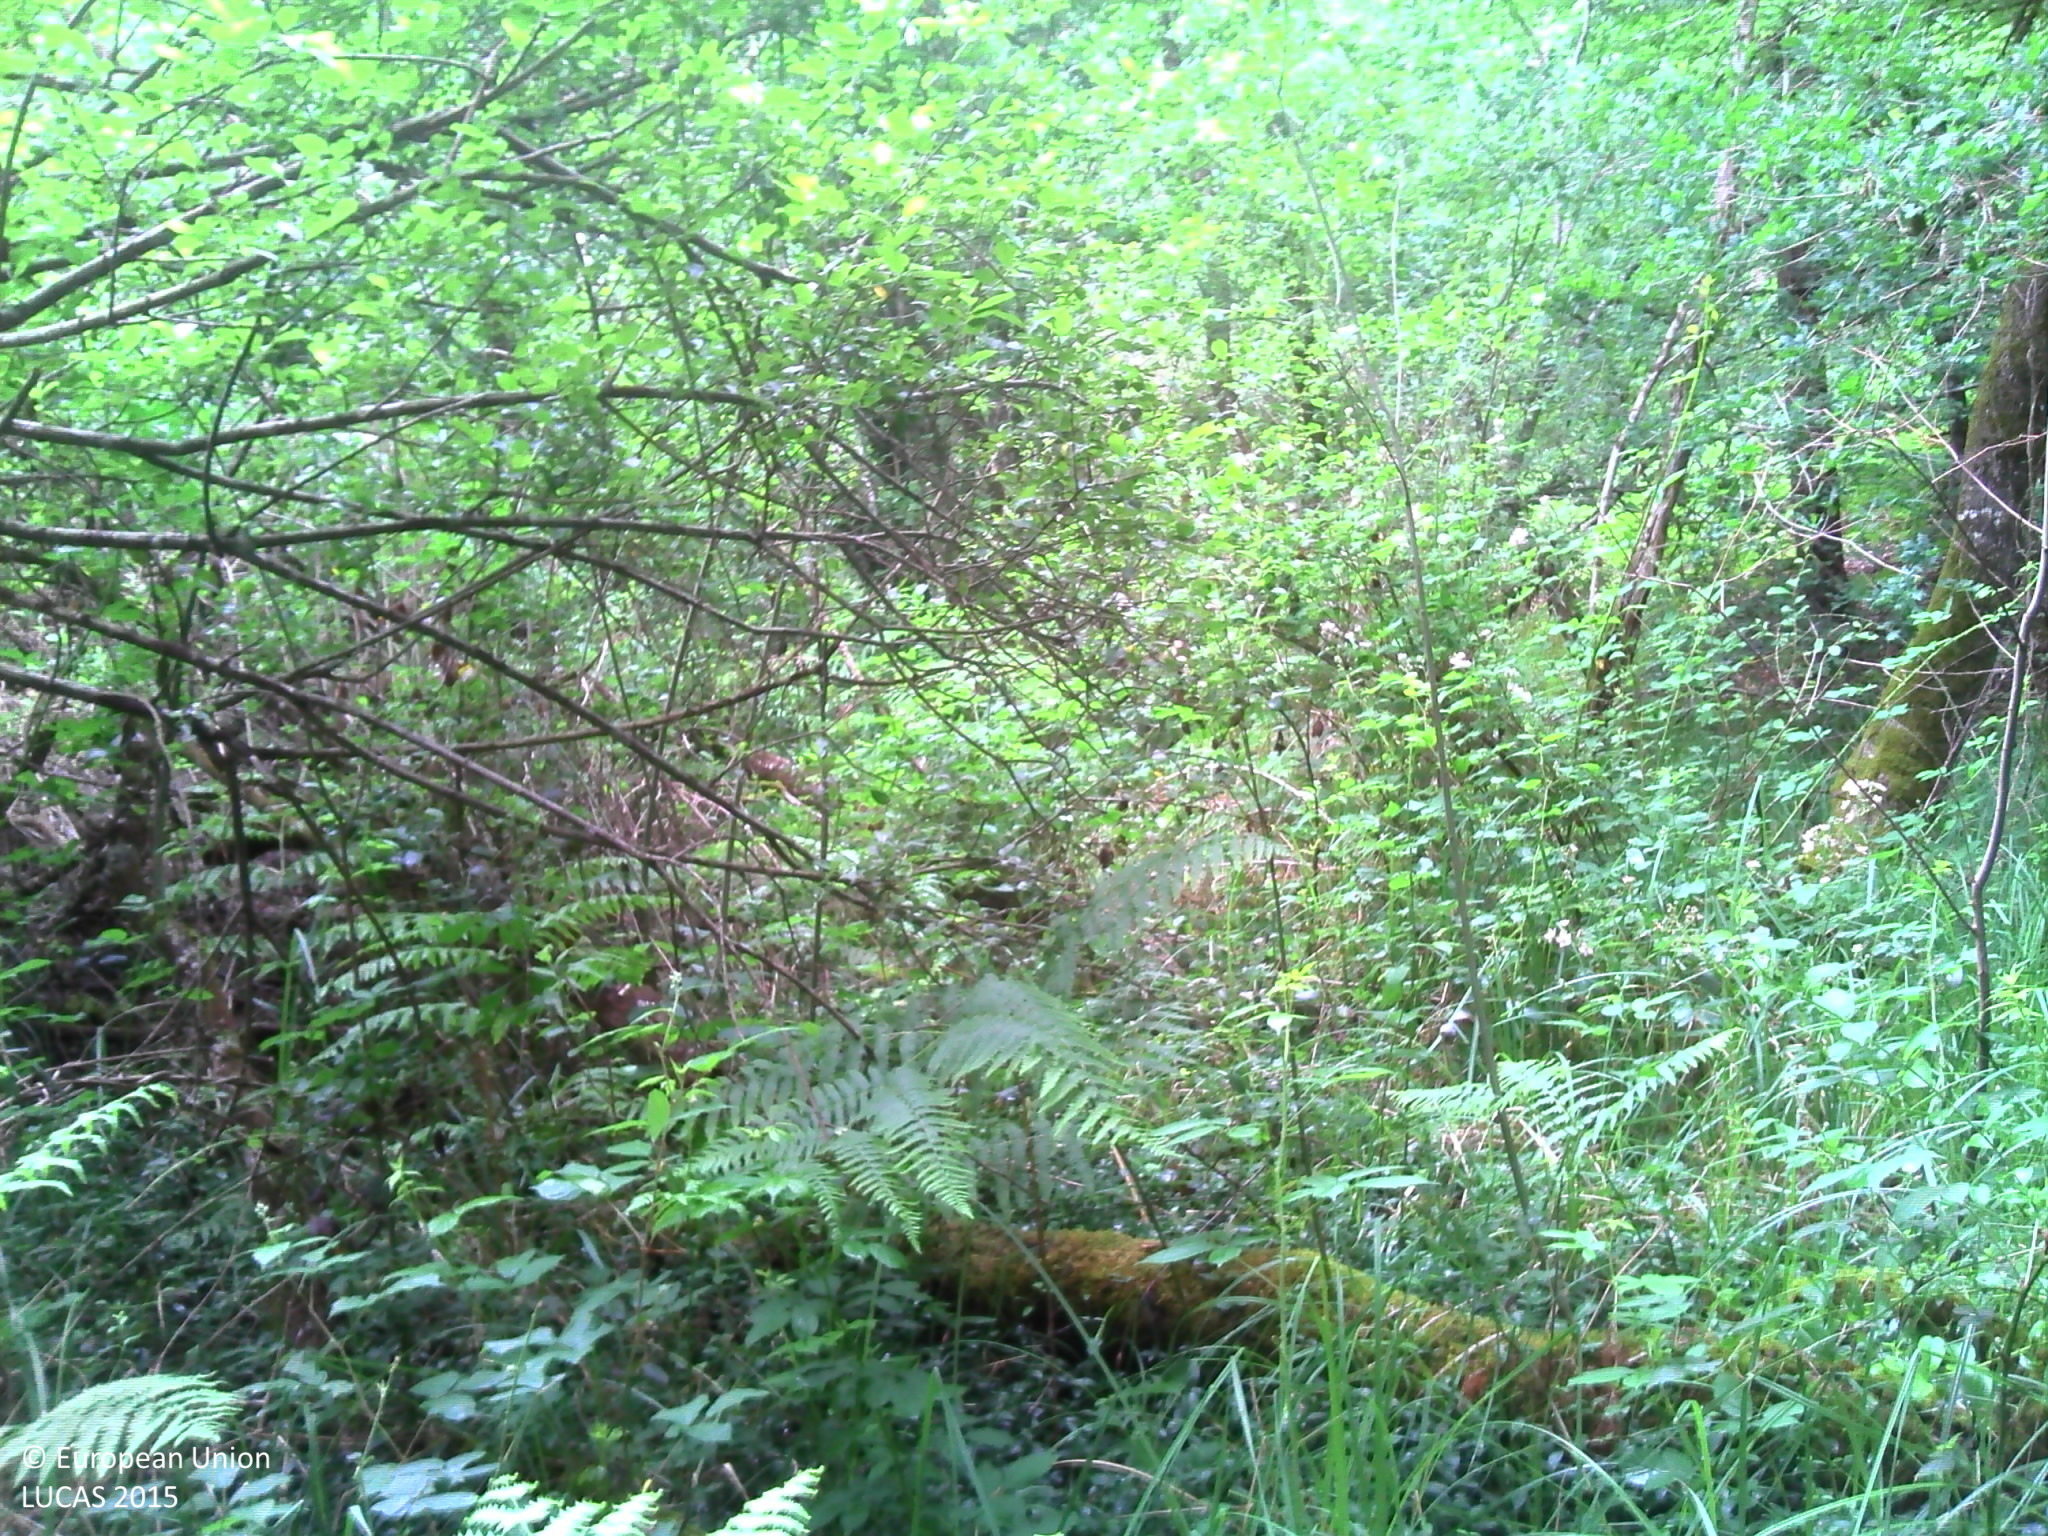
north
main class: Woodland
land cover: Broadleaved woodland
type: acidophilous oak and oak-birch forest
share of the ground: > 75 %
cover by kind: broadleaved forest trees 60 %, herbaceous plants 20 %, coniferous forest trees 10 %, lichens and mosses 10 %
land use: Forestry
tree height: > 5 m
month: June
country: FR
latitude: 47.4808
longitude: 0.0349
